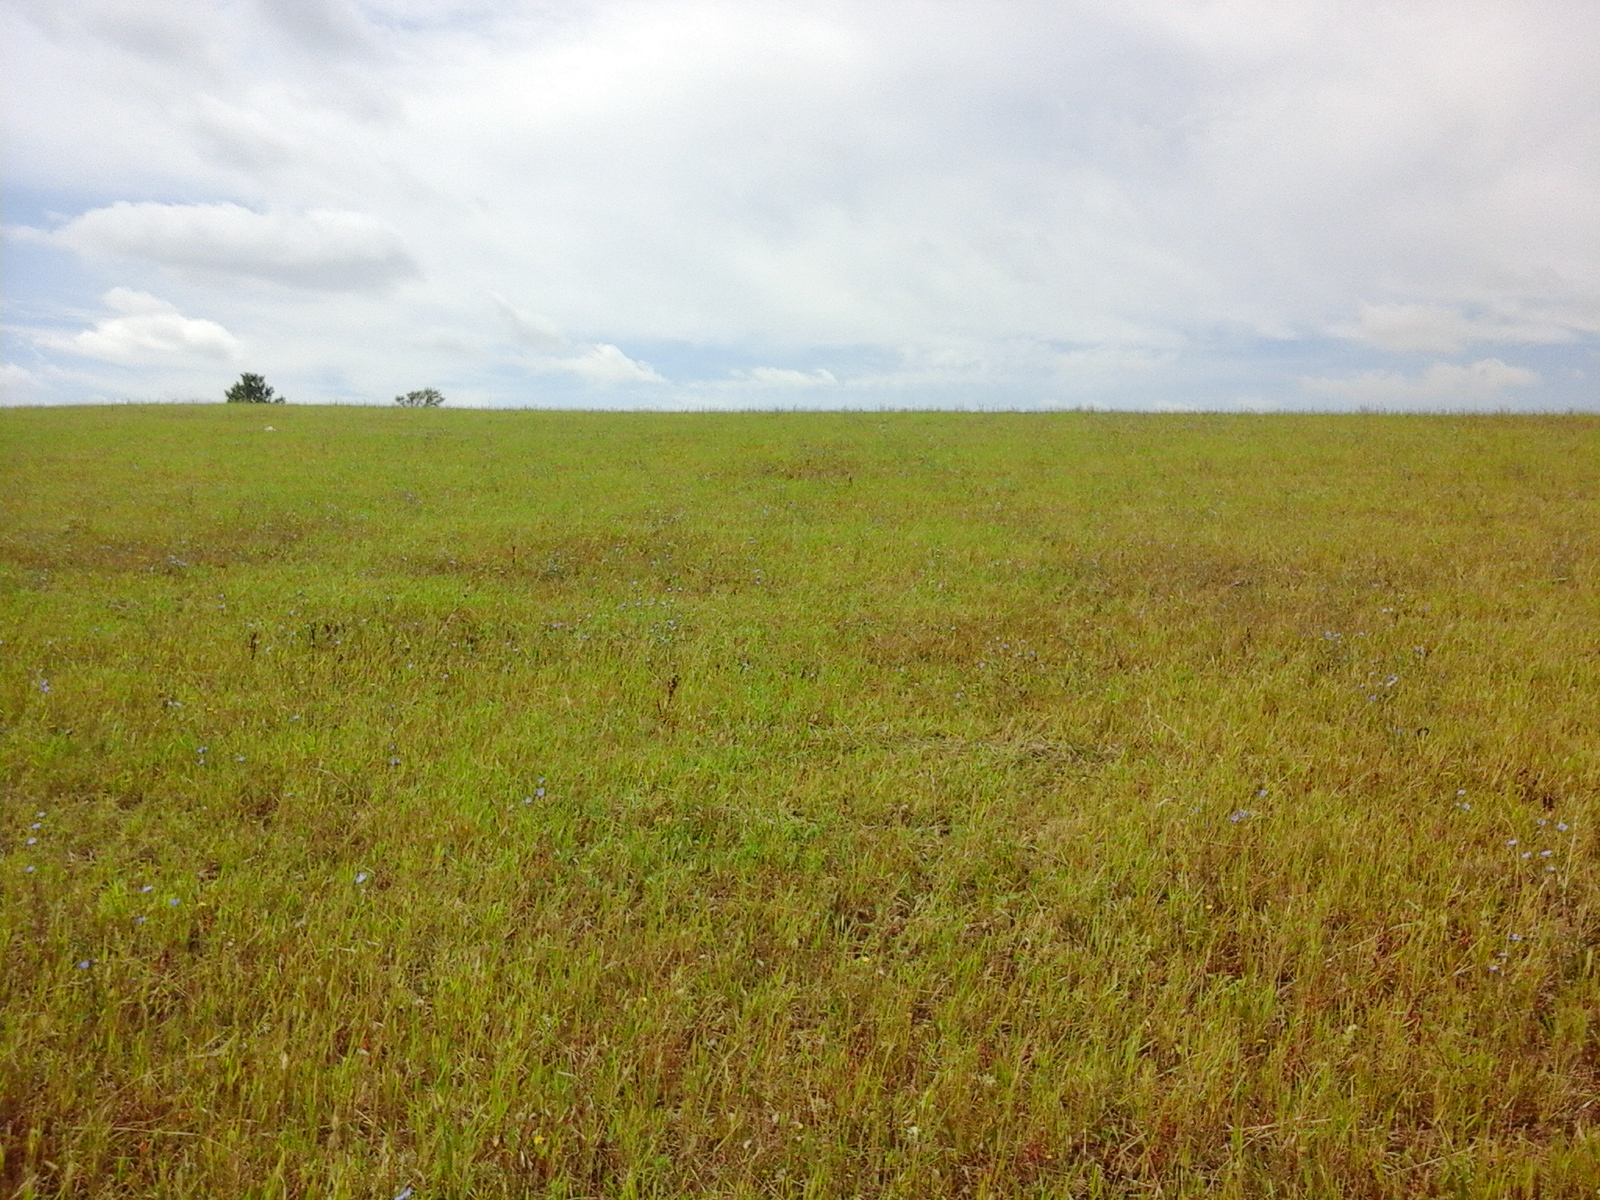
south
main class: Grassland
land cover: Grassland without tree/shrub cover
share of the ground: > 75 %
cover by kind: herbaceous plants 100 %
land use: Agriculture (excluding fallow land and kitchen gardens)
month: August
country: RO
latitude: 45.1517
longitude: 21.6190
